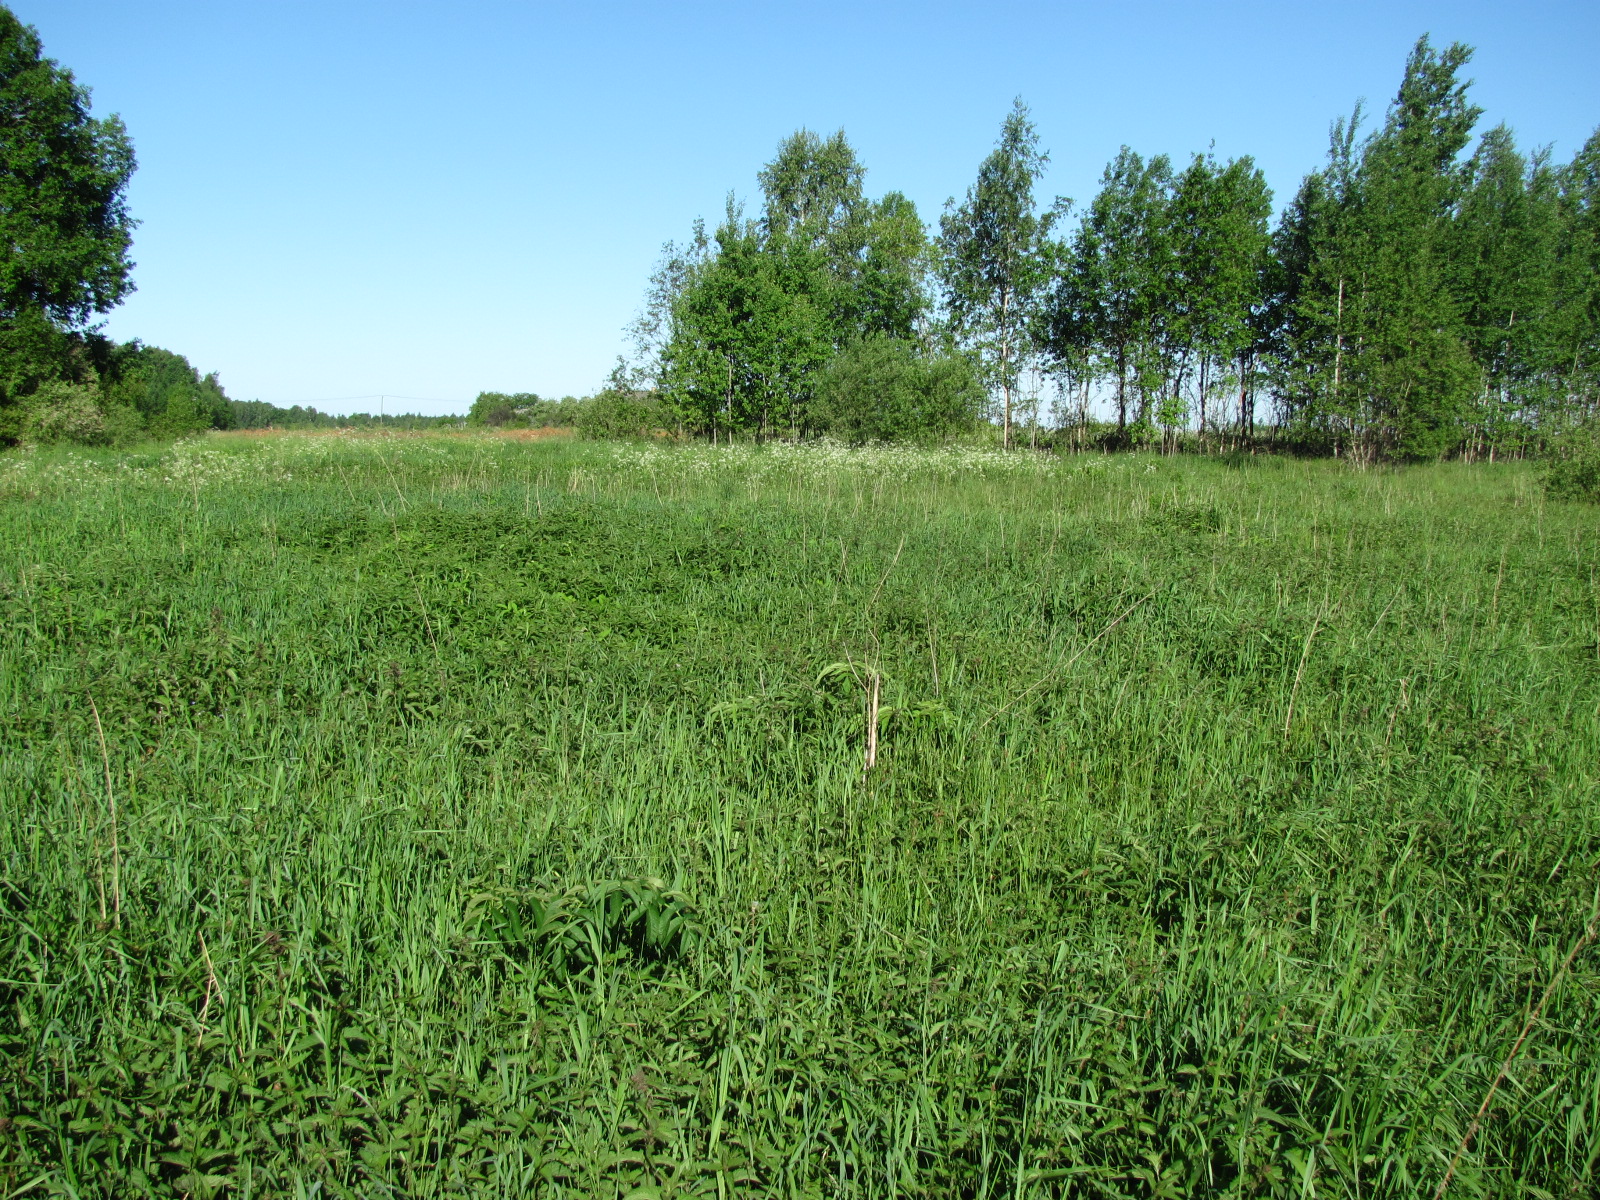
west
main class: Grassland
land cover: Spontaneously vegetated surfaces
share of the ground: > 75 %
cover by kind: herbaceous plants 100 %
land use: Fallow land
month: June
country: LV
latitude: 56.5564
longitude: 24.2612
